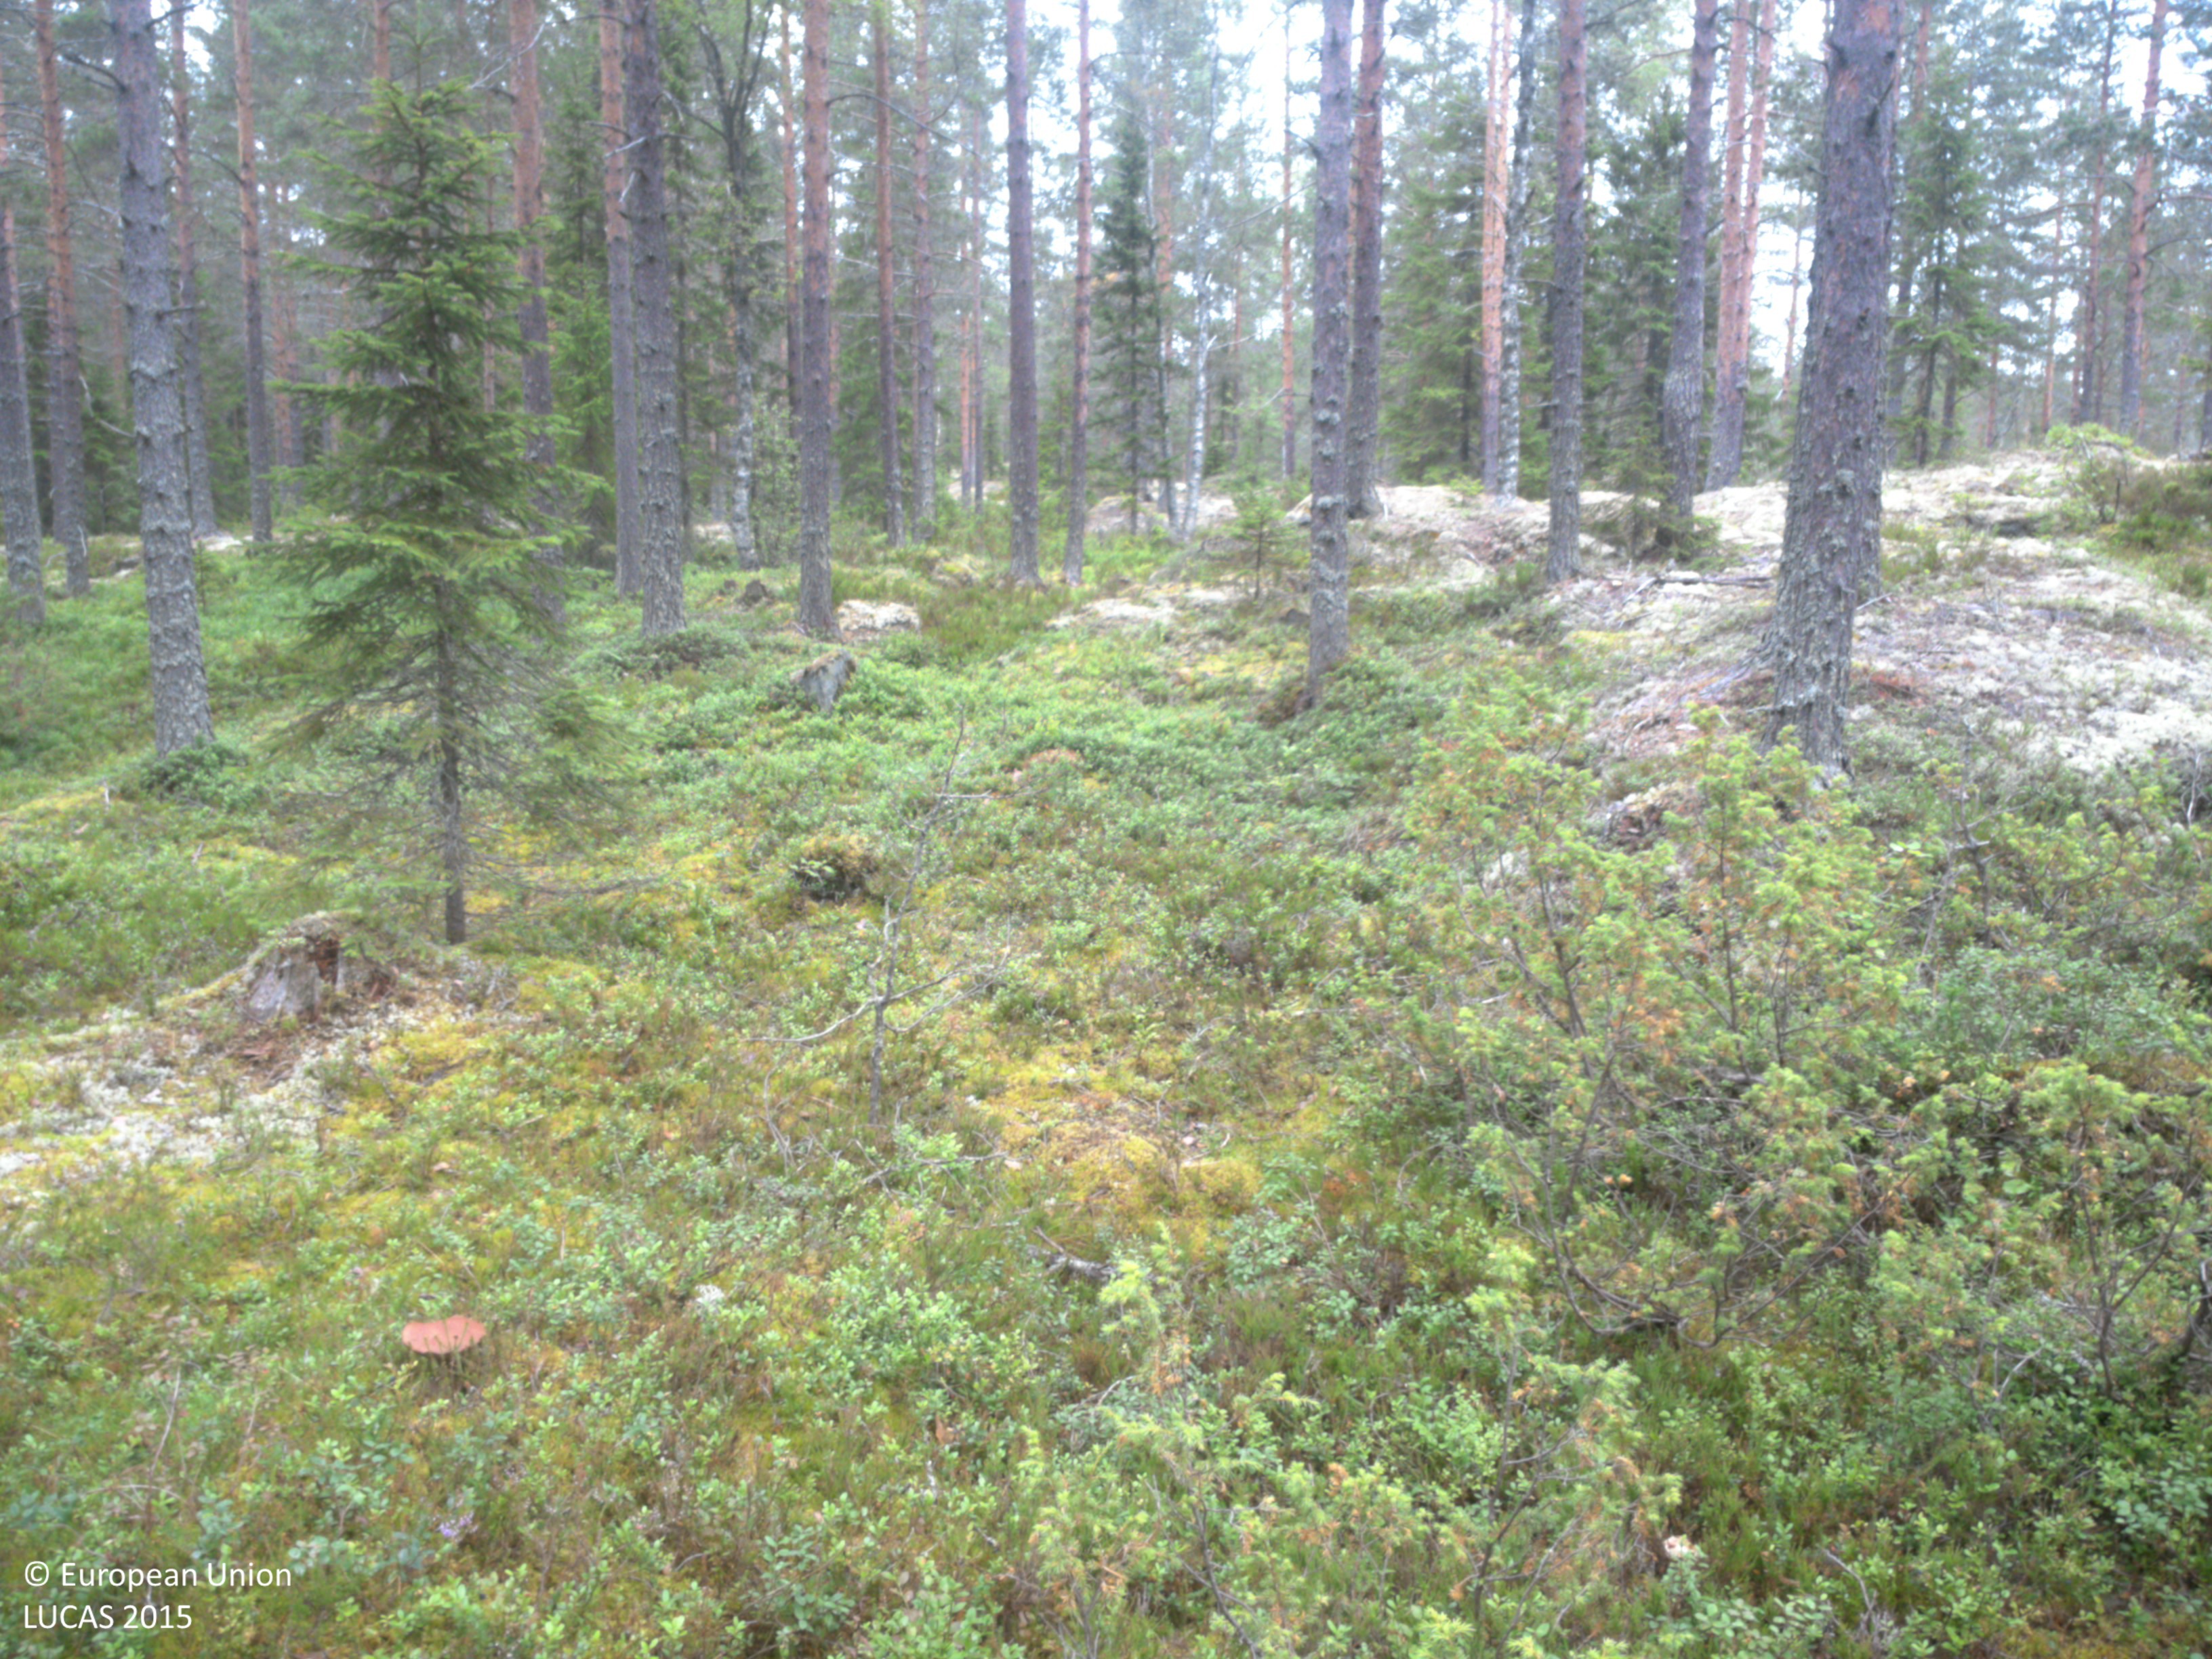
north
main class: Woodland
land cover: Pine dominated coniferous woodland
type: boreal forest
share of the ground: 50 - 75 %
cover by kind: coniferous forest trees 50 %, shrubs 35 %, lichens and mosses 15 %
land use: Forestry
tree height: > 5 m
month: August
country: SE
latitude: 63.7276
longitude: 19.8413
